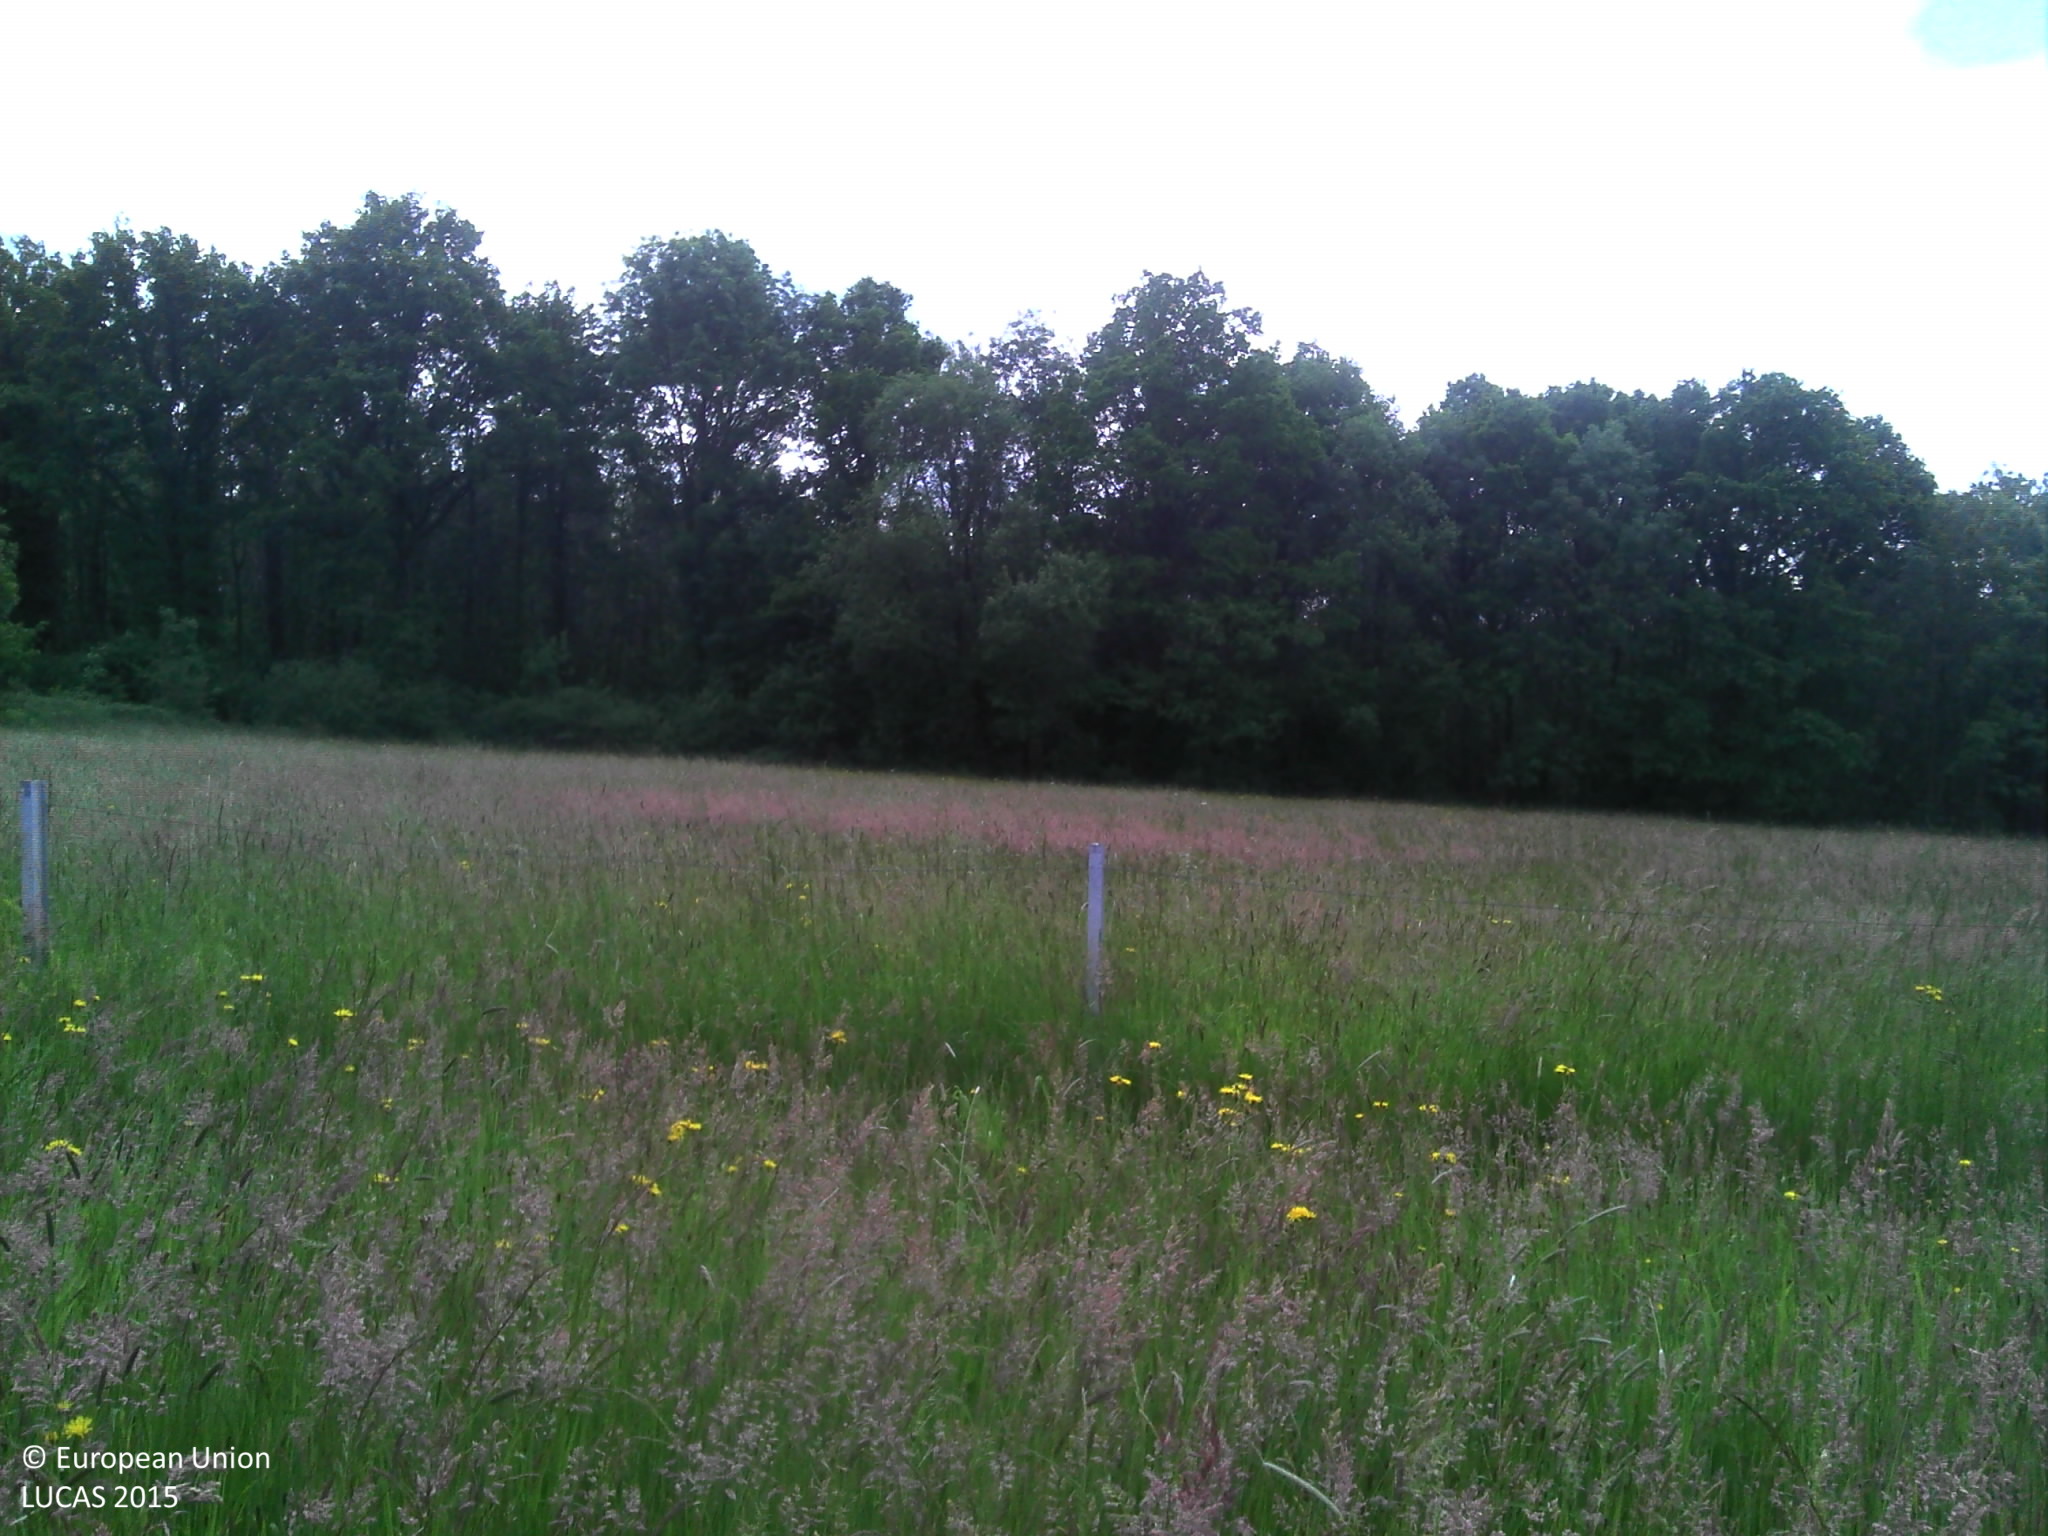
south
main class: Grassland
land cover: Grassland without tree/shrub cover
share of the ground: > 75 %
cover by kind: herbaceous plants 100 %
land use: Agriculture (excluding fallow land and kitchen gardens)
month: May
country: BE
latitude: 50.1751
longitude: 4.8300
